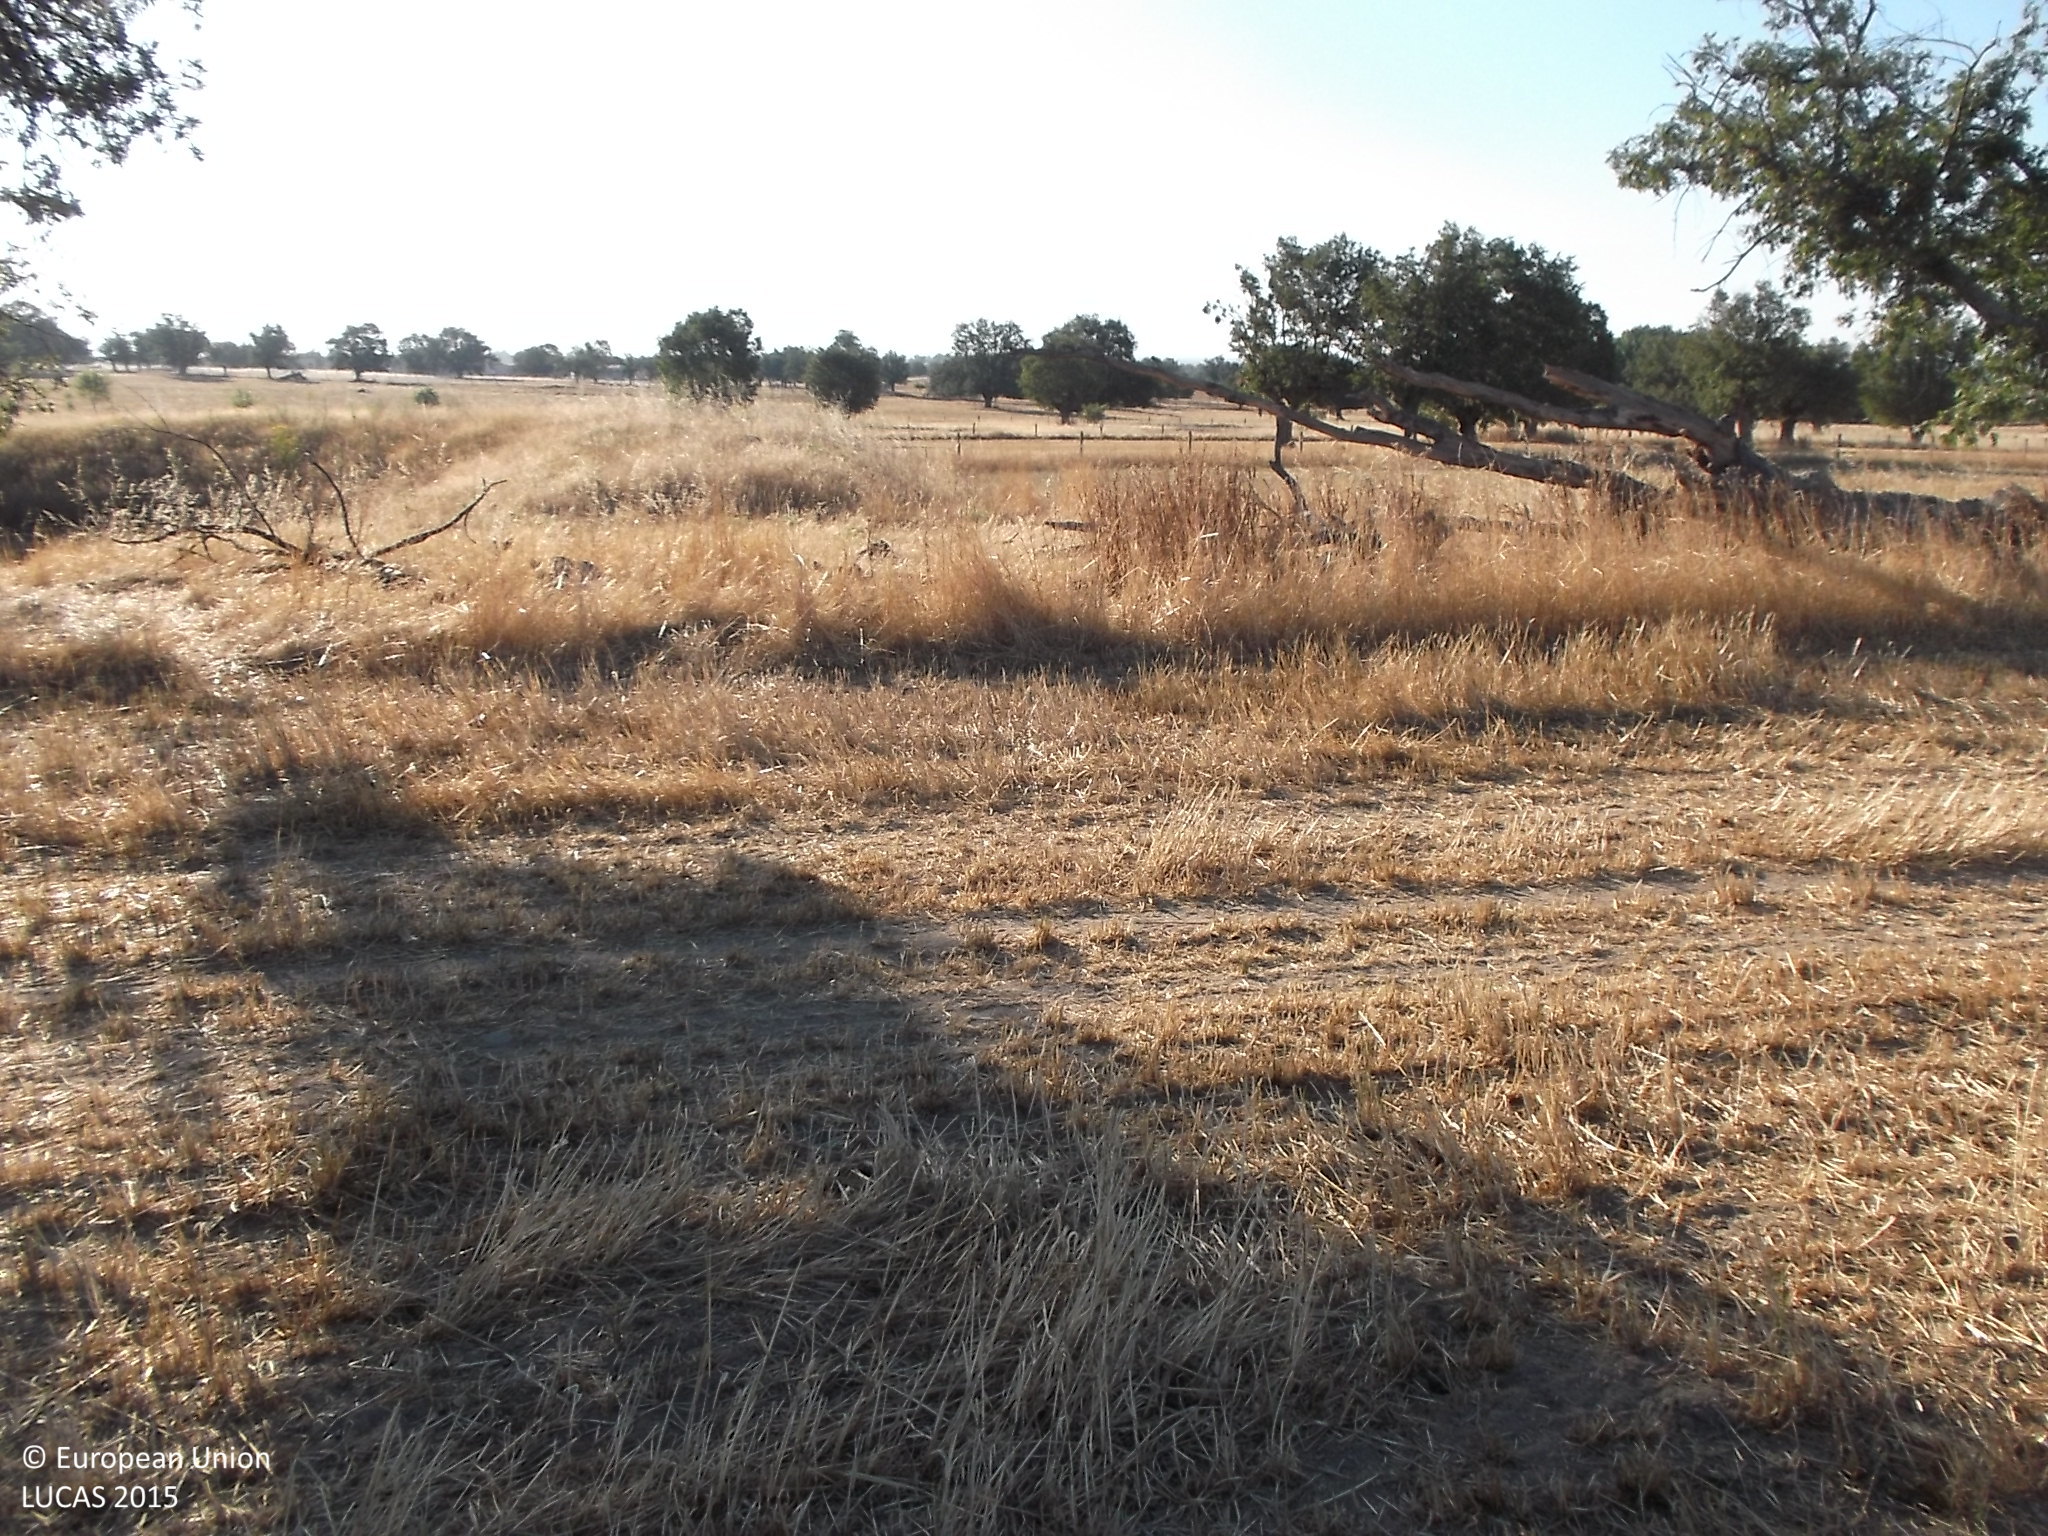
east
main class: Cropland
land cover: Mixed cereals for fodder
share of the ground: < 10 %
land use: Agriculture (excluding fallow land and kitchen gardens)
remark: Harvested field
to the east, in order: Mixed cereals for fodder; Grassland without tree/shrub cover; Fences; Grass margins; Mixed cereals for fodder; Grass margins; Fences; Grassland without tree/shrub cover; Fences; Grassland without tree/shrub cover
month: July
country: ES
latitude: 41.1069
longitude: -6.4937
